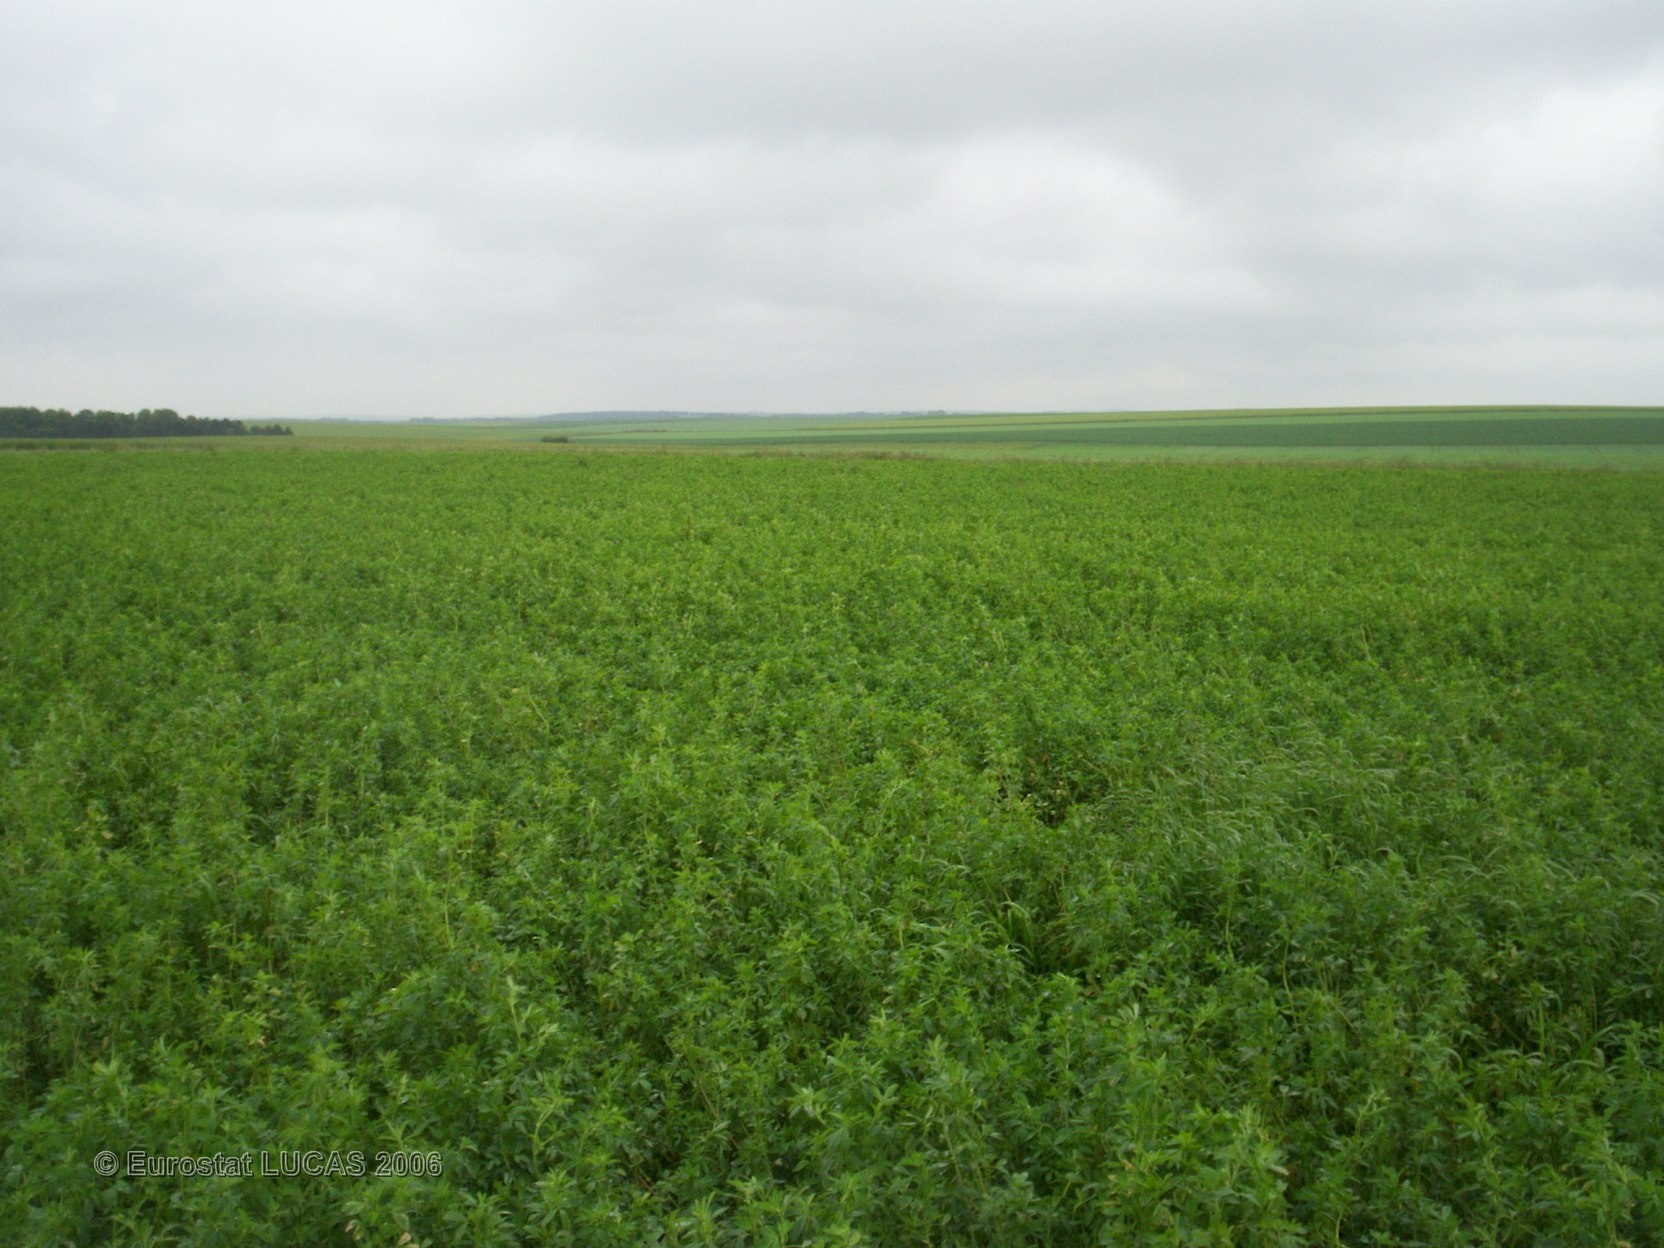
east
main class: Cropland
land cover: Lucerne
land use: Agriculture (excluding fallow land and kitchen gardens)
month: May
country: FR
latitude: 49.3805
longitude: 4.4175
